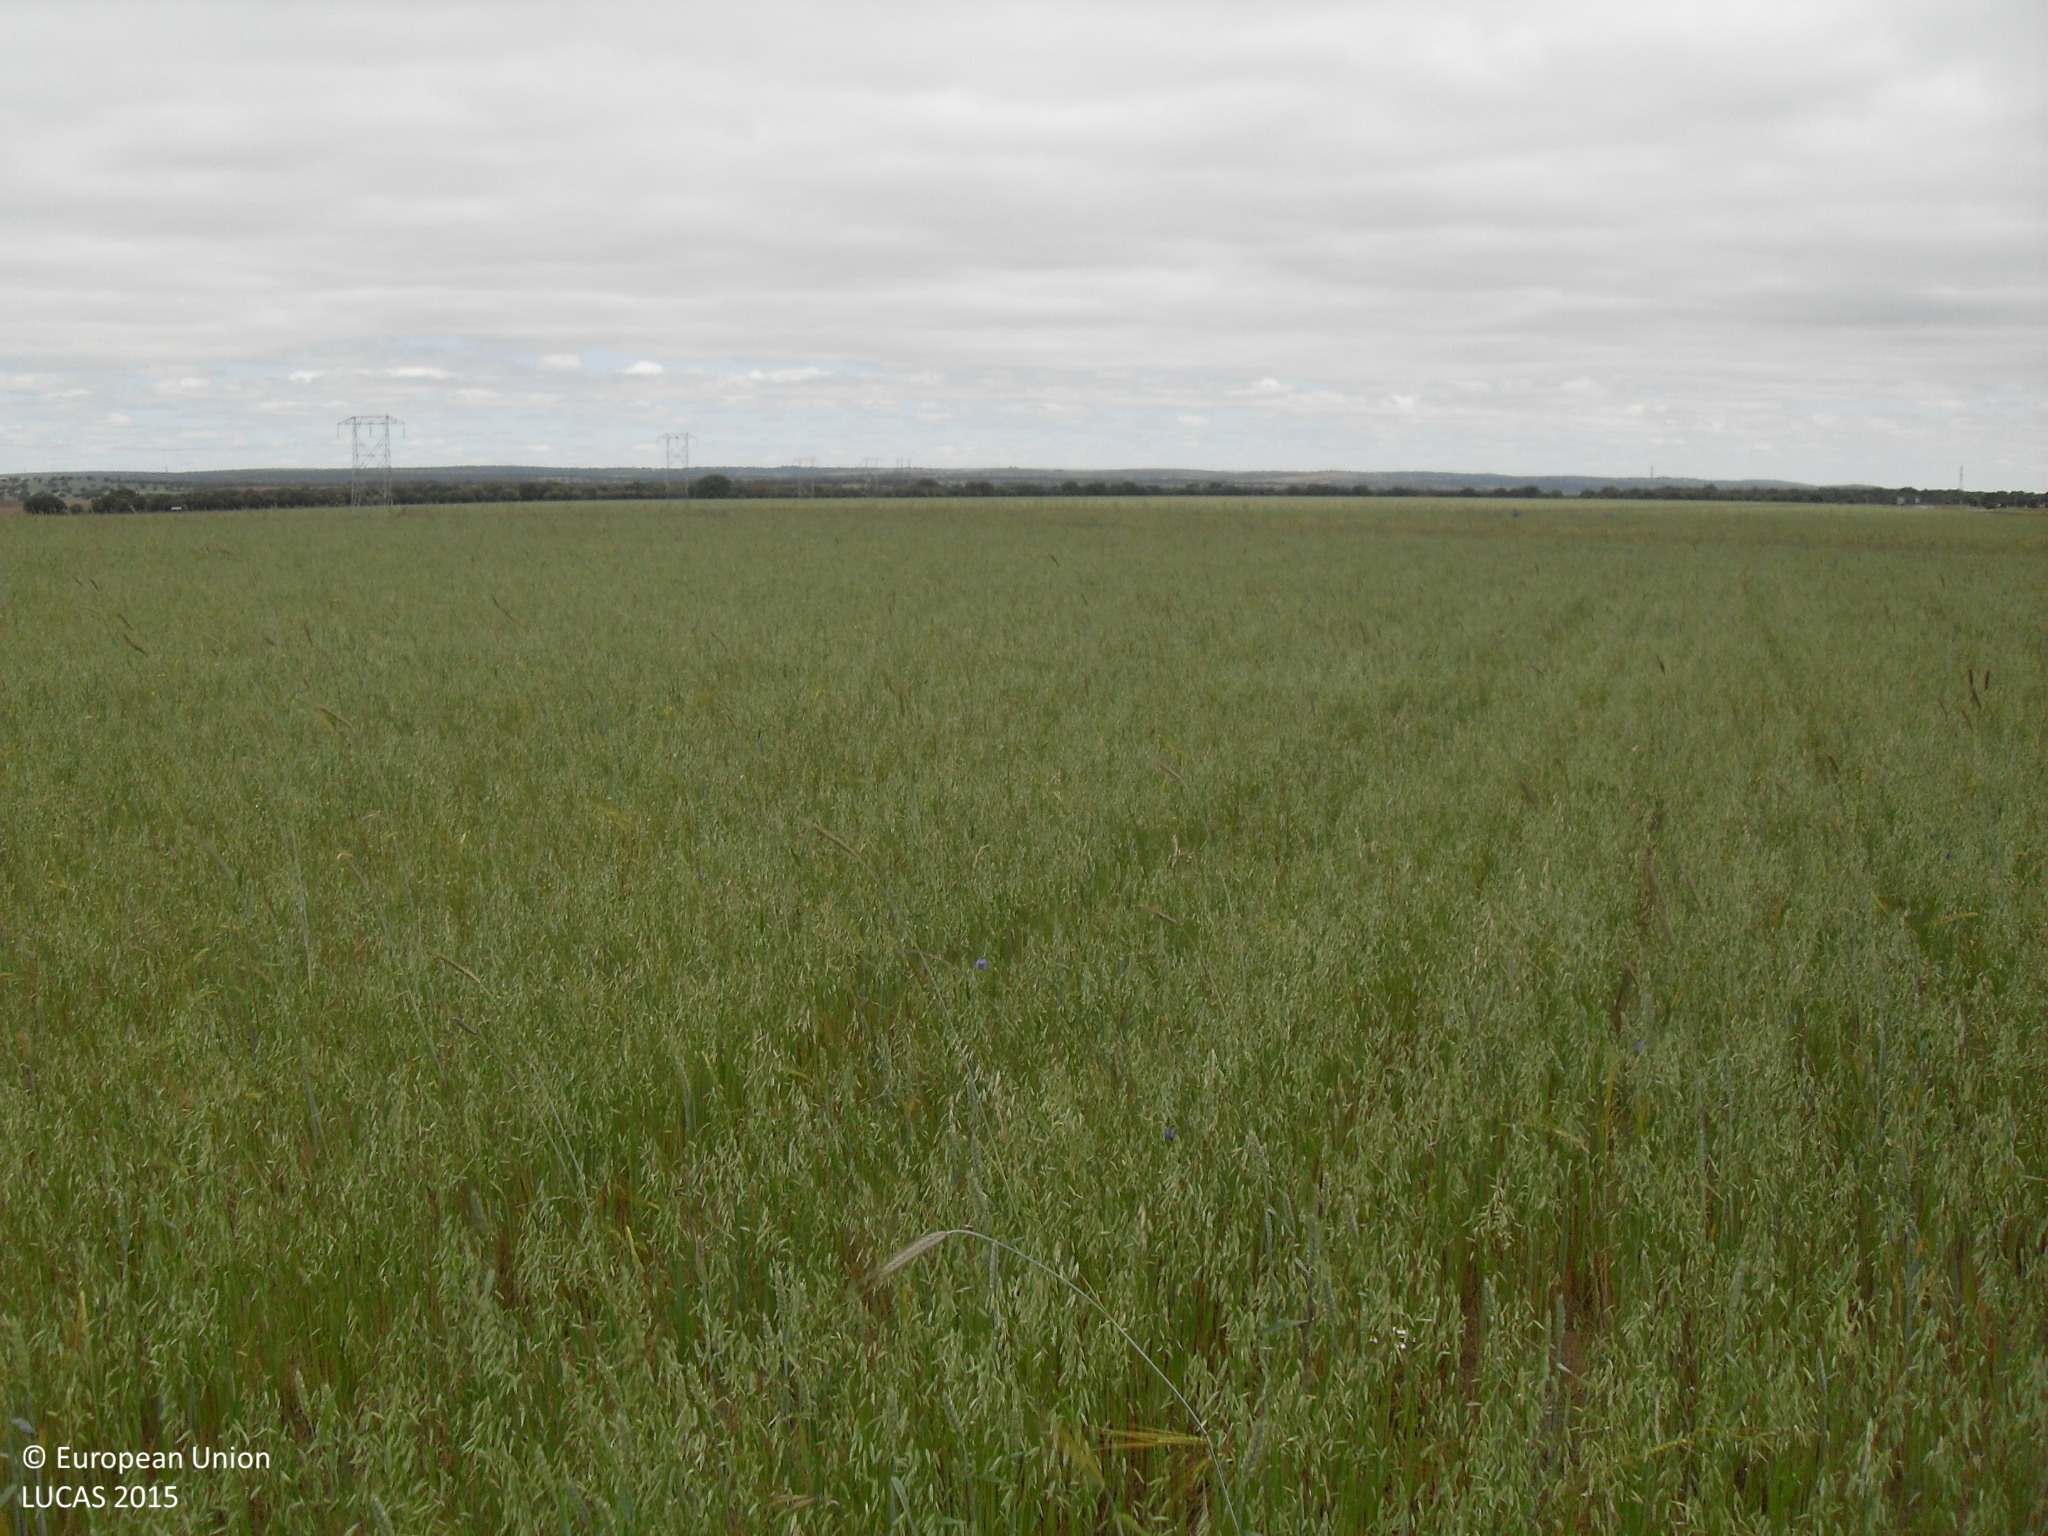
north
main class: Cropland
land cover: Oats
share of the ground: > 75 %
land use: Agriculture (excluding fallow land and kitchen gardens)
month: May
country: ES
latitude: 40.6610
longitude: -5.6260
